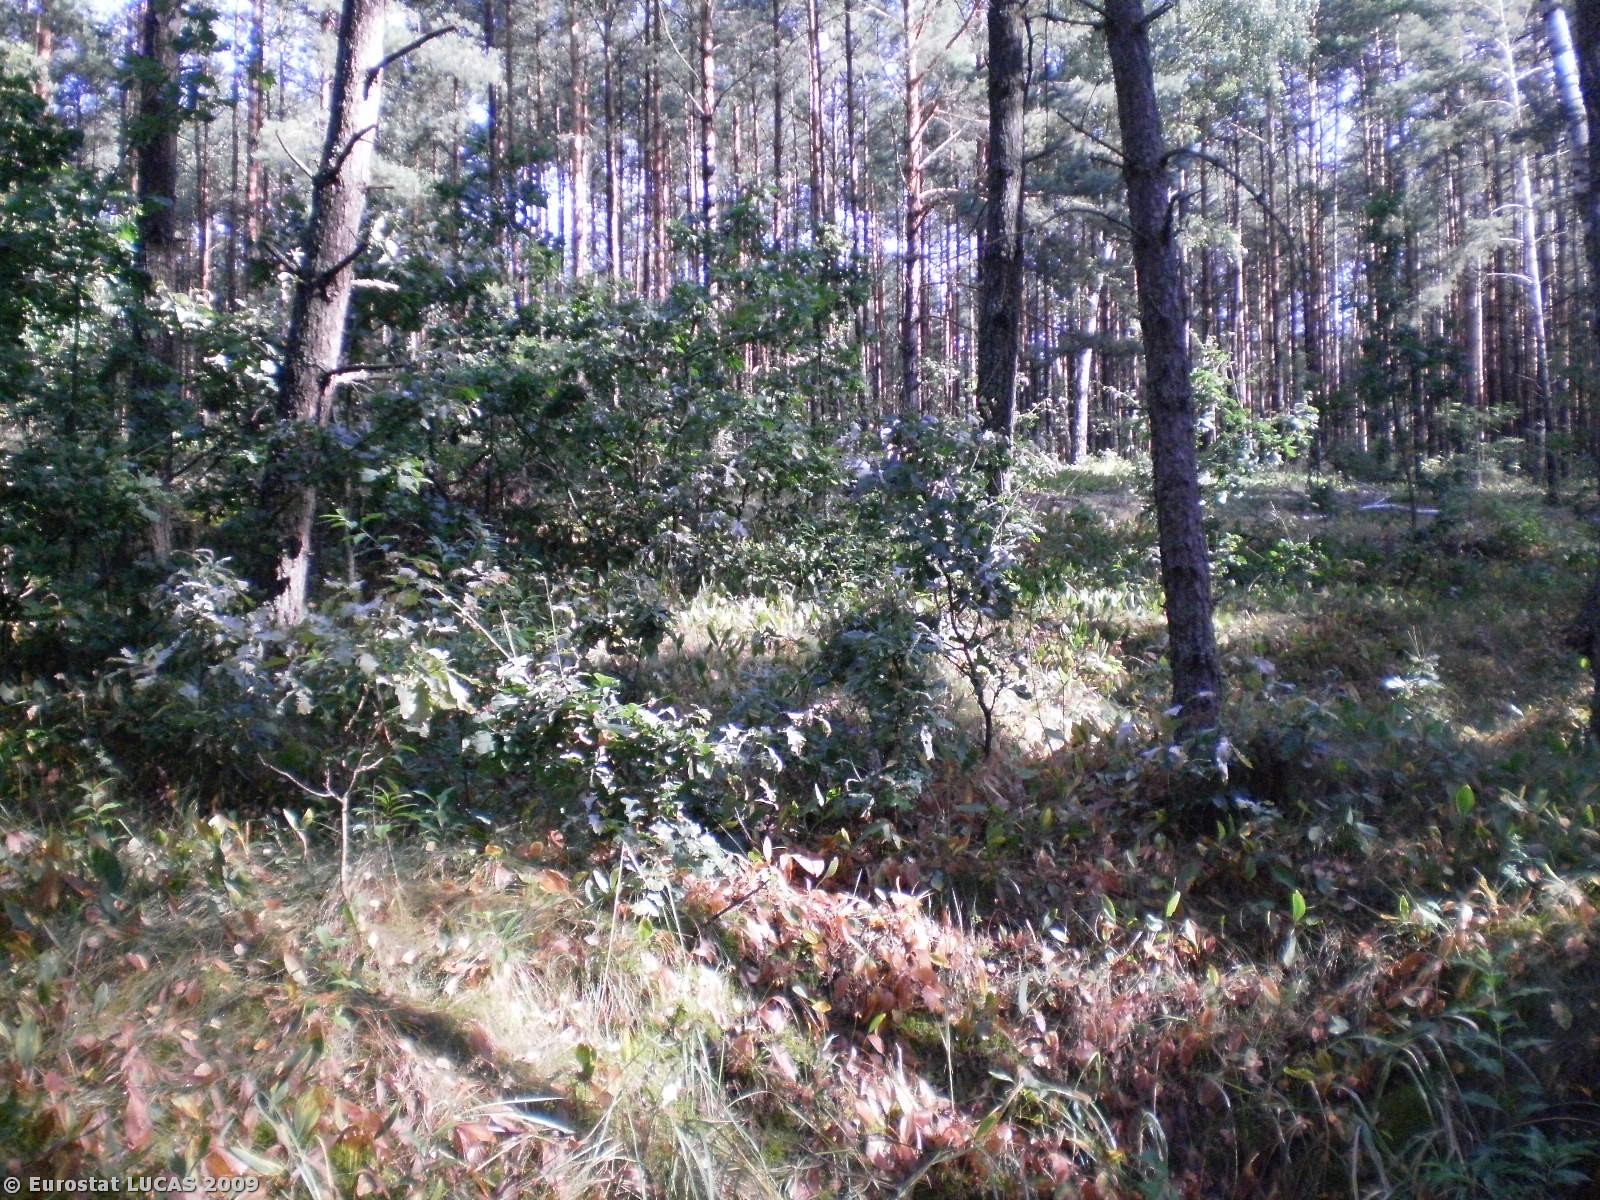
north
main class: Woodland
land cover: Coniferous woodland
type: hemiboreal forest and nemoral coniferous forest and mixed broadleaved-coniferous forest
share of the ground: > 75 %
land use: Forestry
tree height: > 5 m
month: August
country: PL
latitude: 52.7586
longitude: 21.1446
